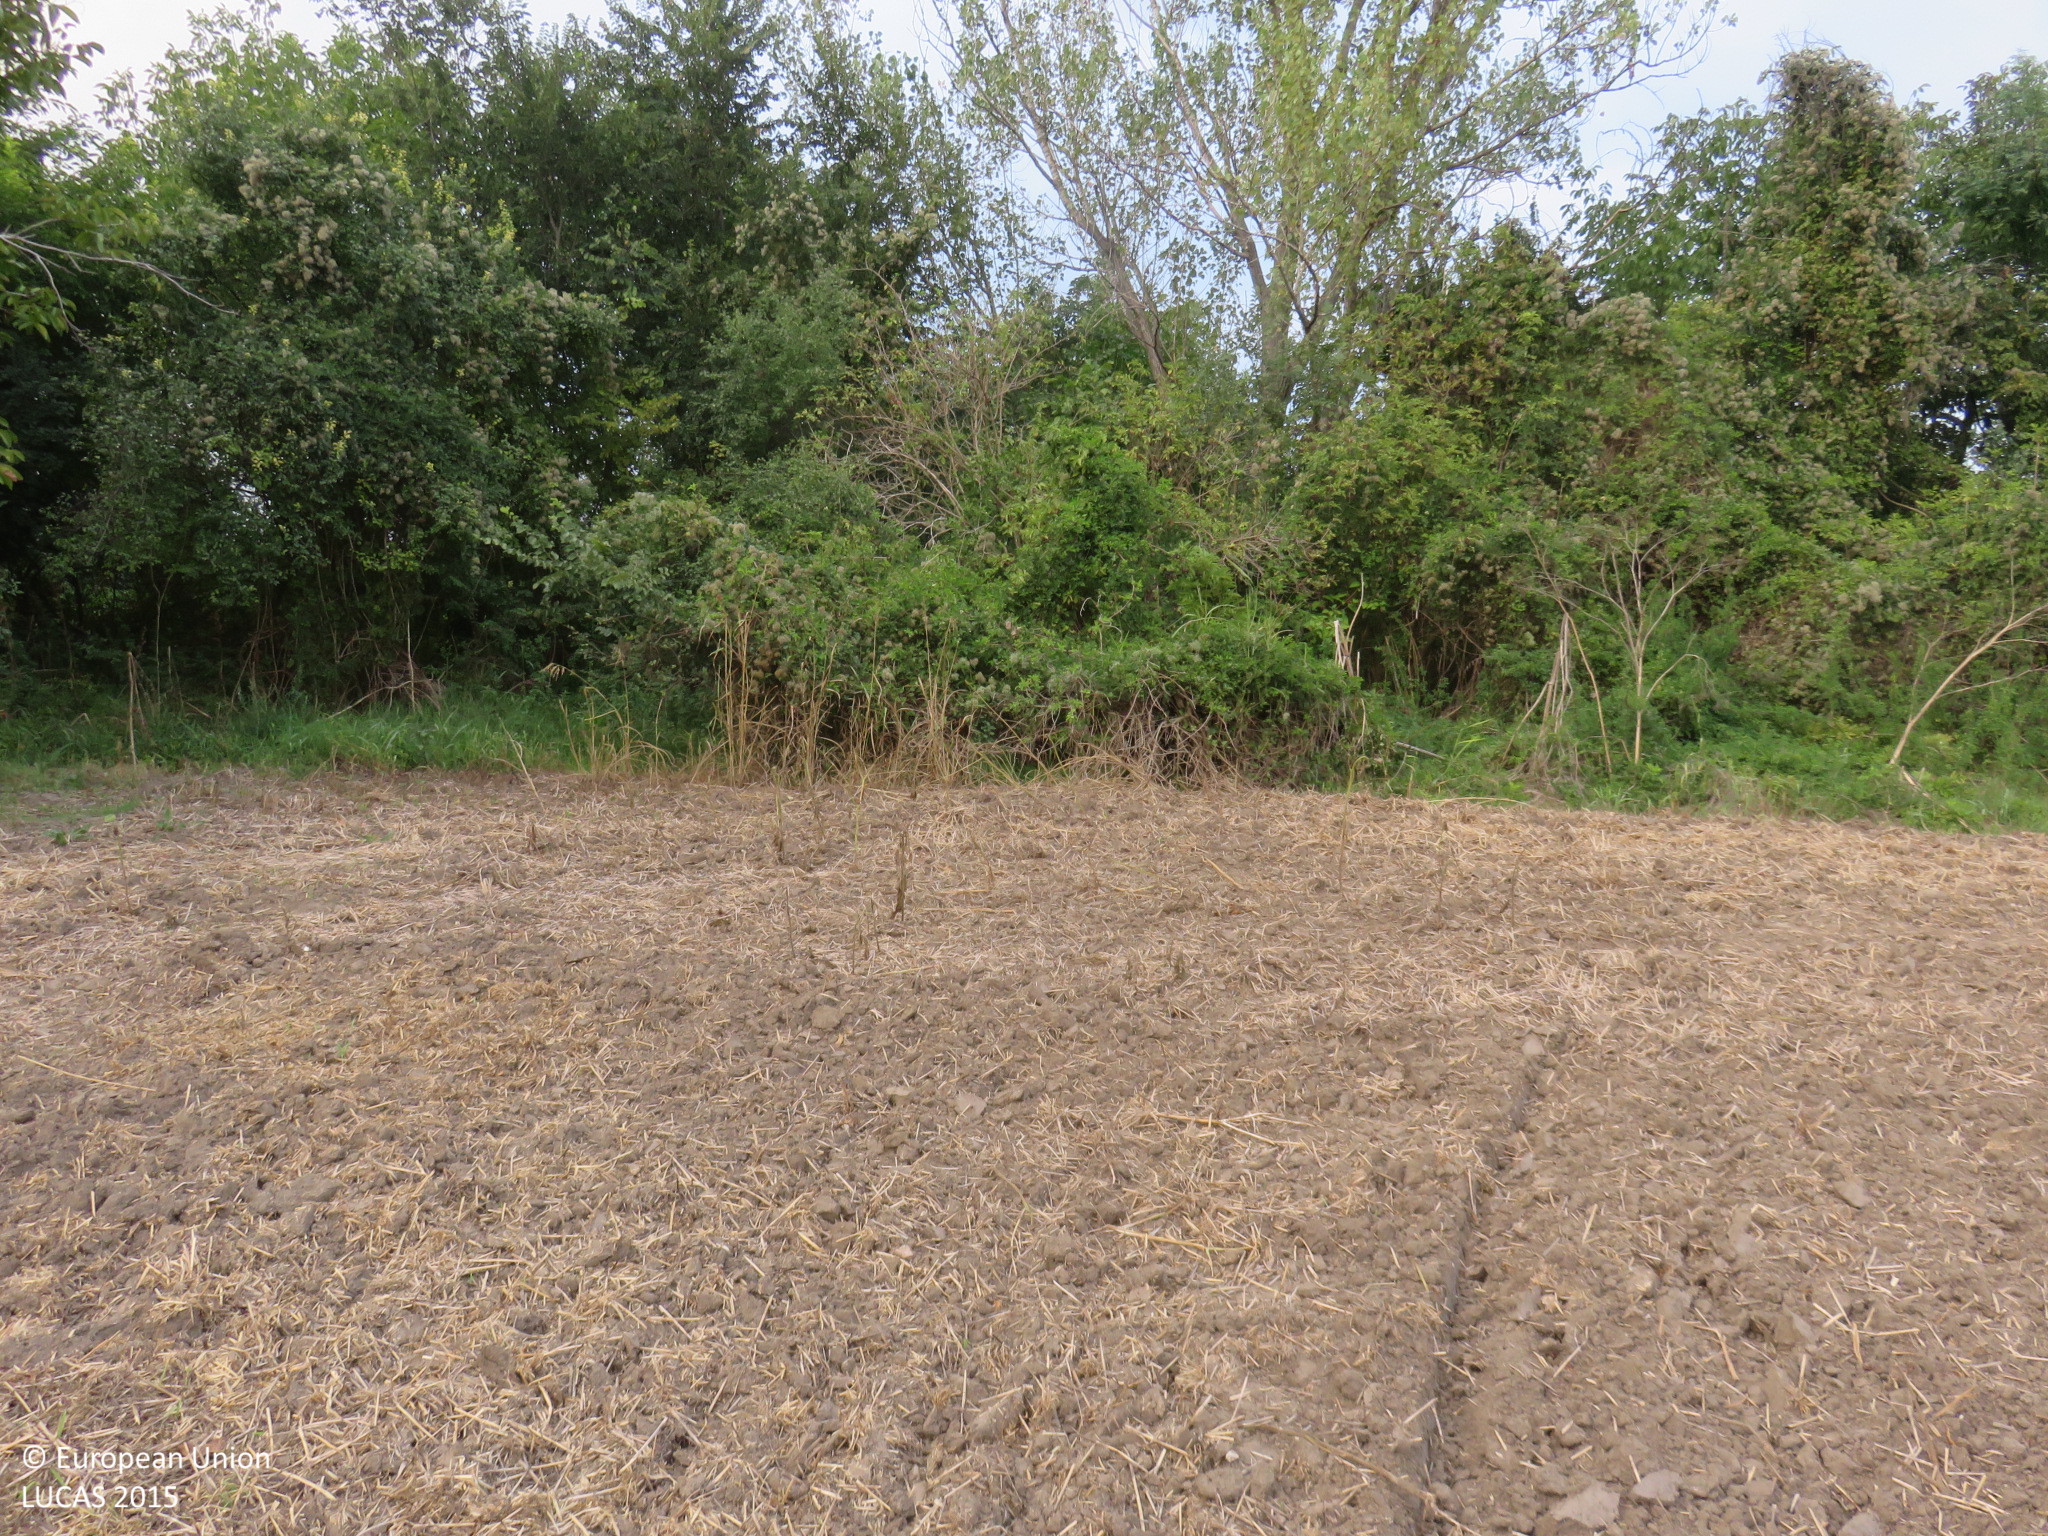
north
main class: Cropland
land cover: Common wheat
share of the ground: 10 - 25 %
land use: Agriculture (excluding fallow land and kitchen gardens)
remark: Harvested field
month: September
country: BG
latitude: 43.5553
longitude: 24.9374
